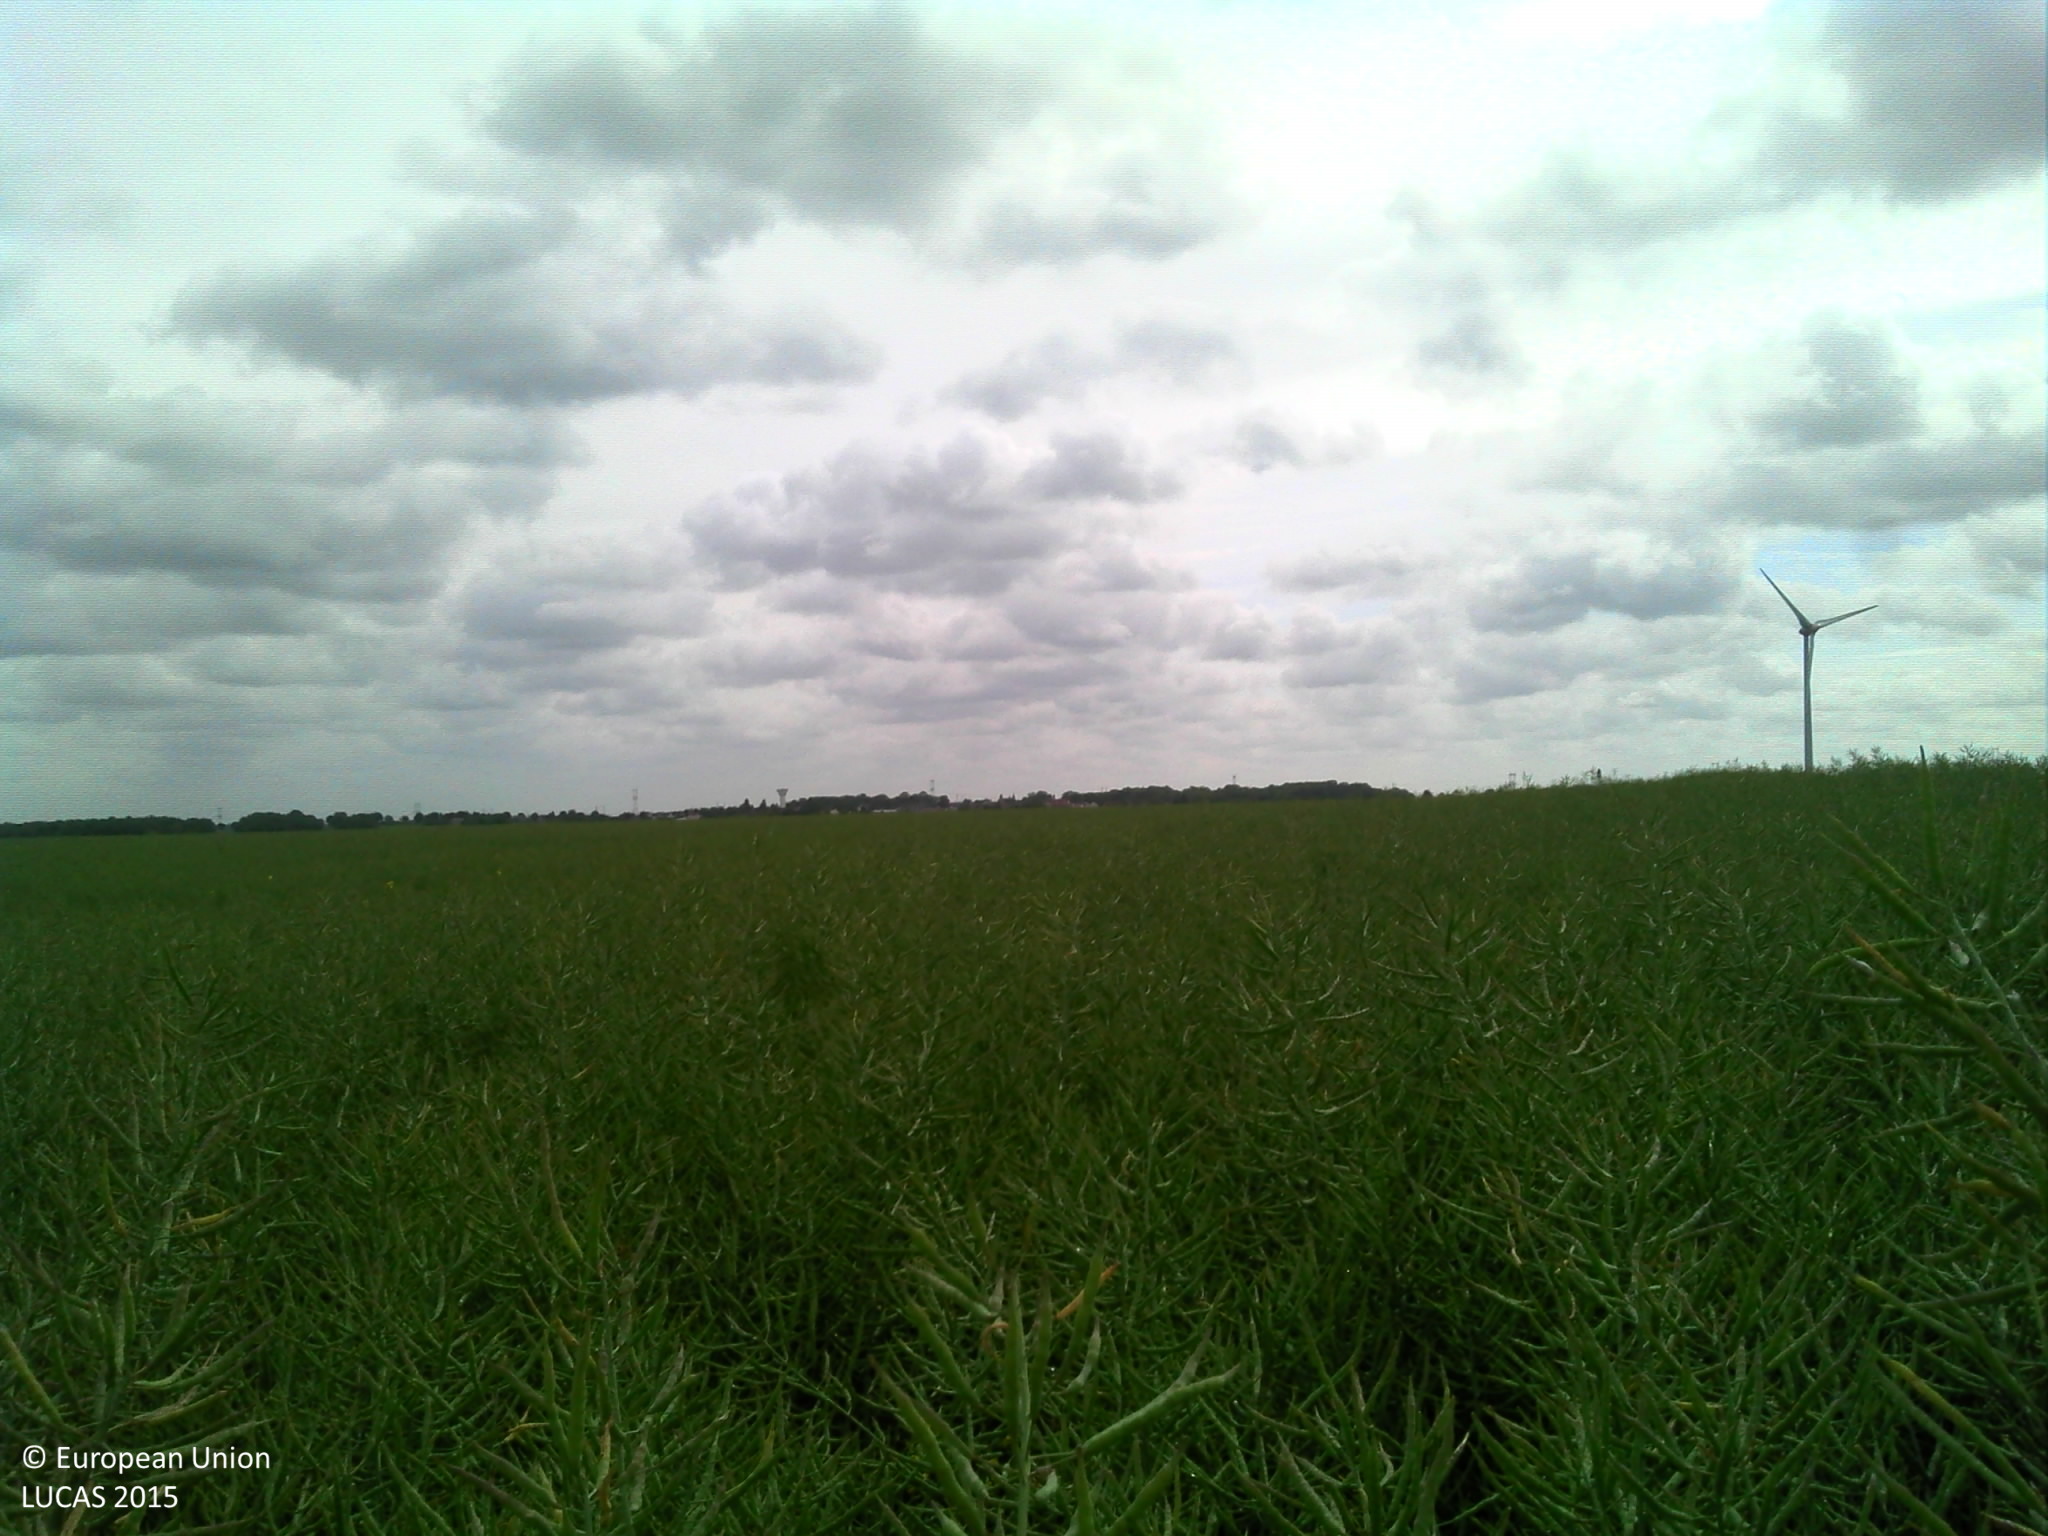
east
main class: Cropland
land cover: Rape and turnip rape
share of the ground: > 75 %
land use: Agriculture (excluding fallow land and kitchen gardens)
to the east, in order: Rape and turnip rape
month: June
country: FR
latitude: 48.3453
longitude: 1.9584
